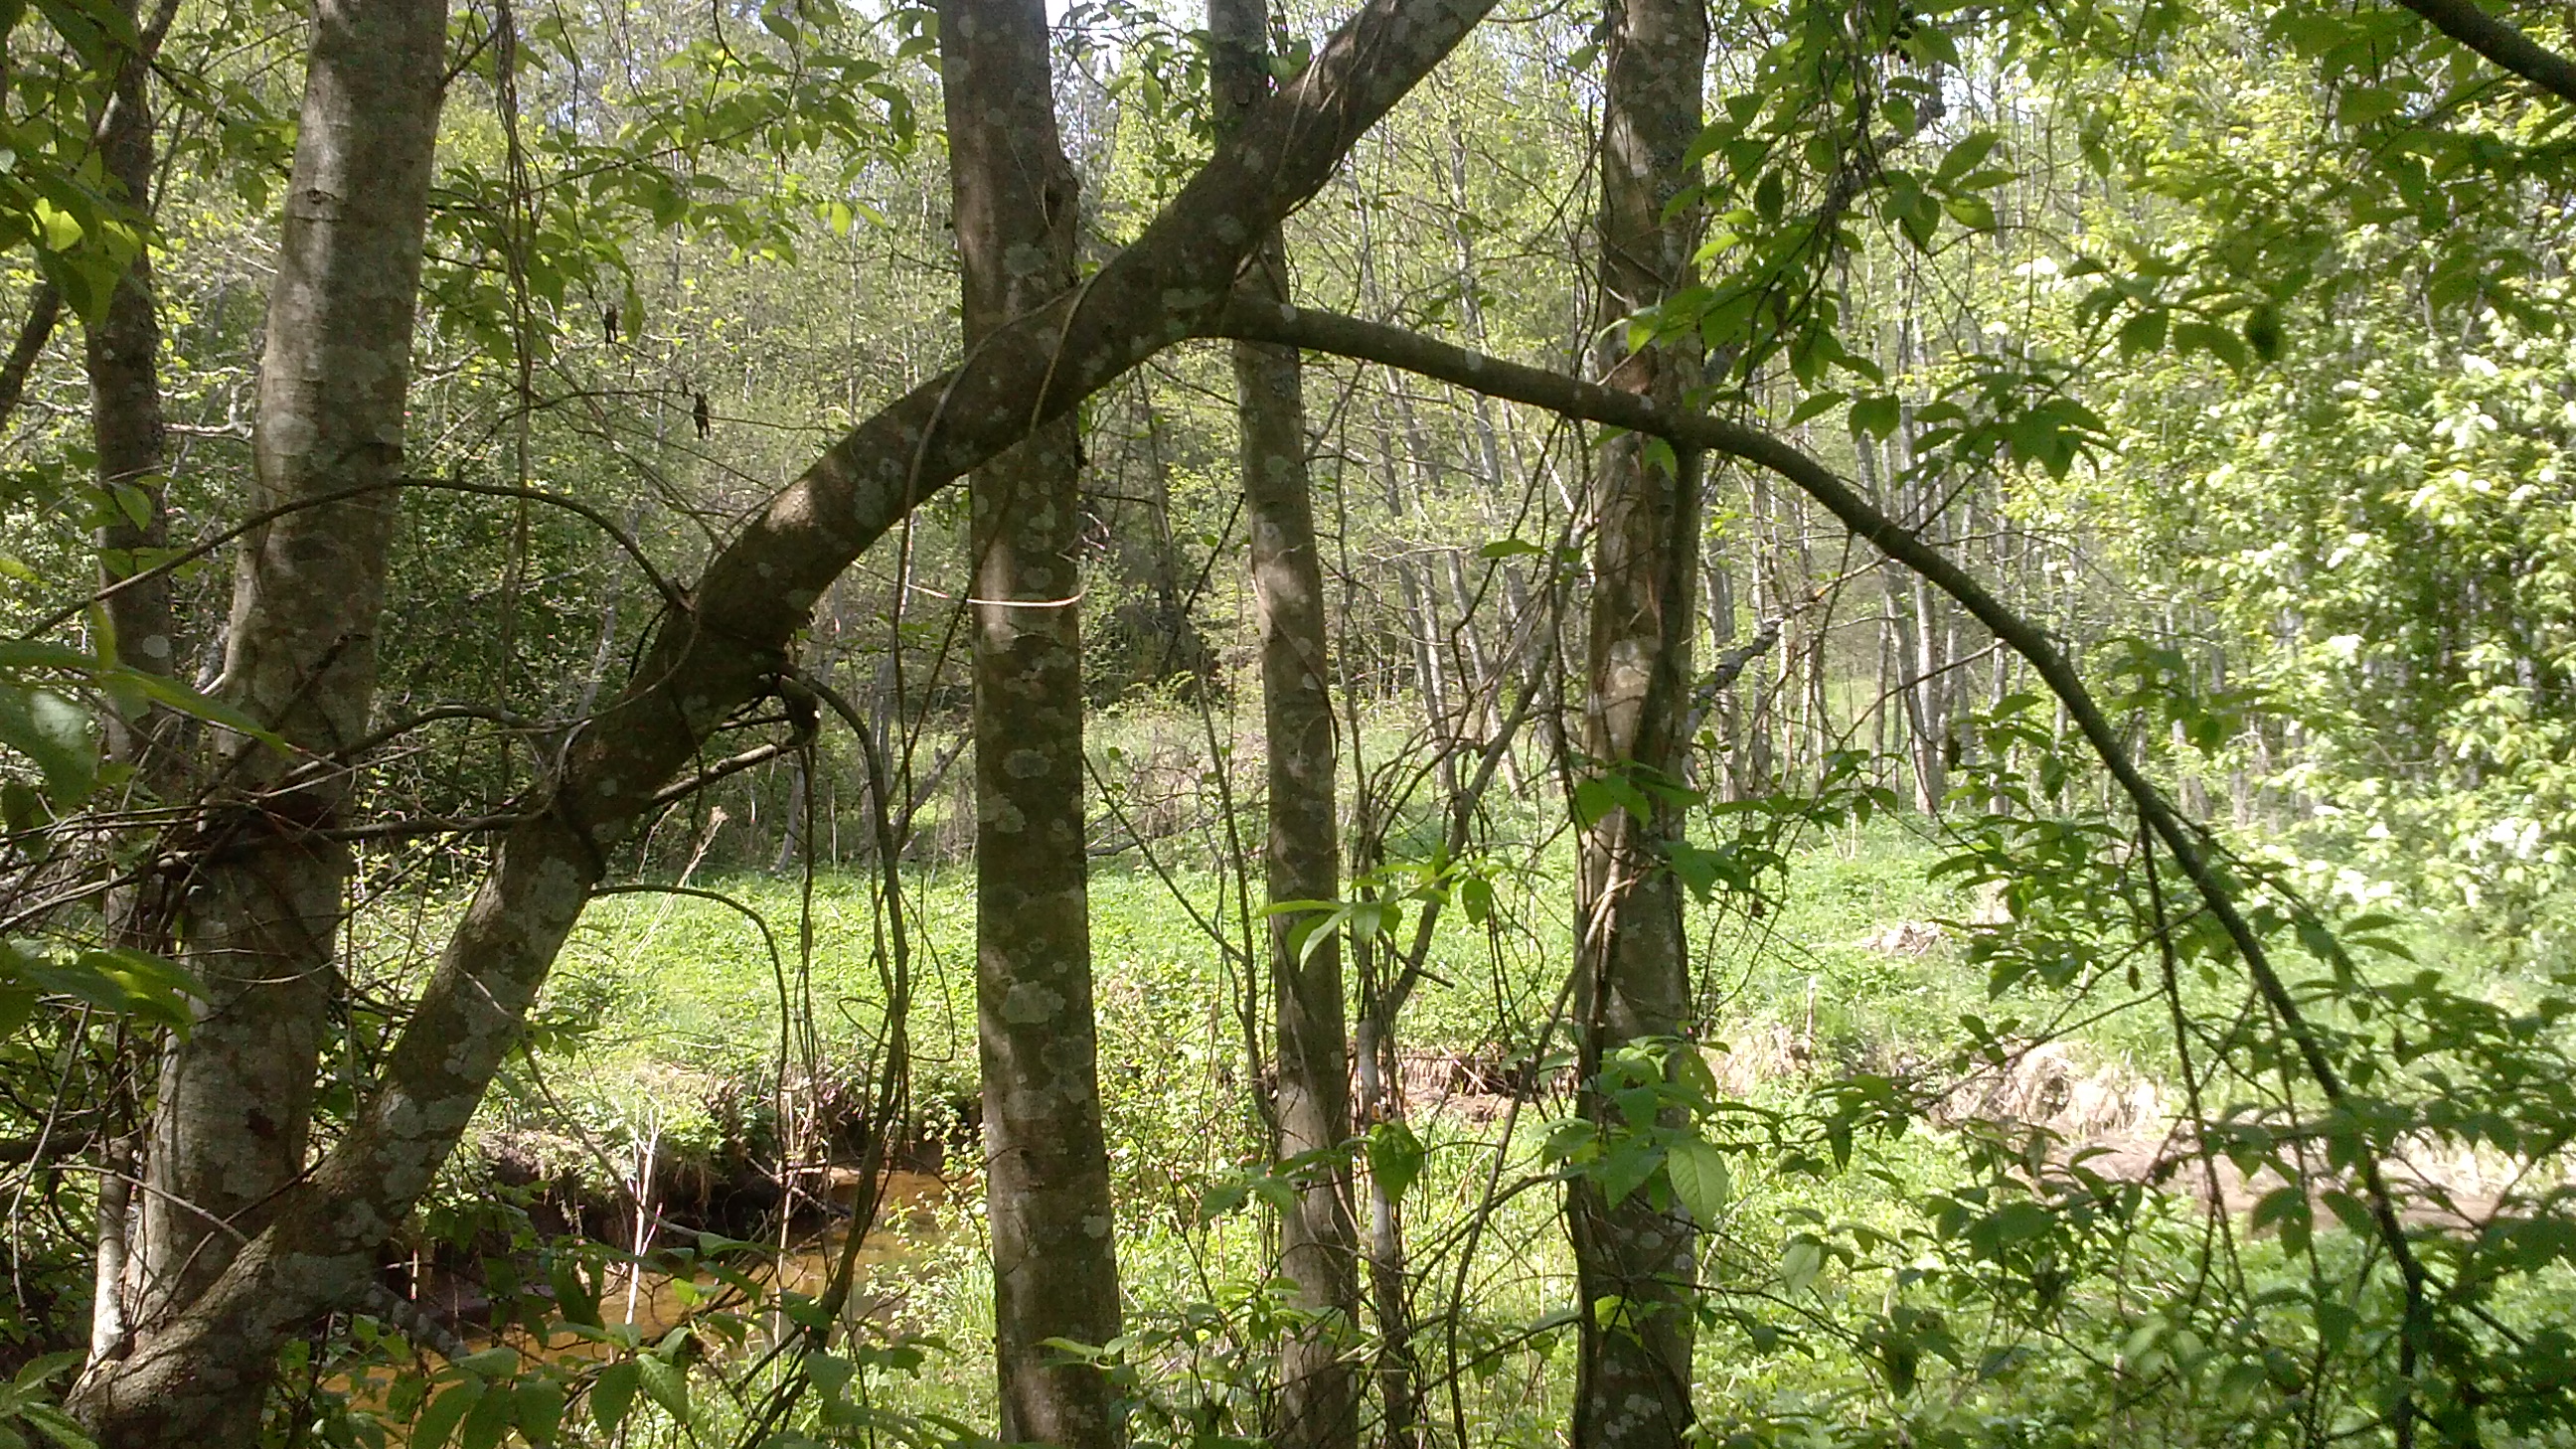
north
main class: Woodland
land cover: Broadleaved woodland
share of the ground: > 75 %
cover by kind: broadleaved forest trees 100 %
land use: Semi-natural and natural areas not in use
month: May
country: LV
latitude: 55.8929
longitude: 27.2352
